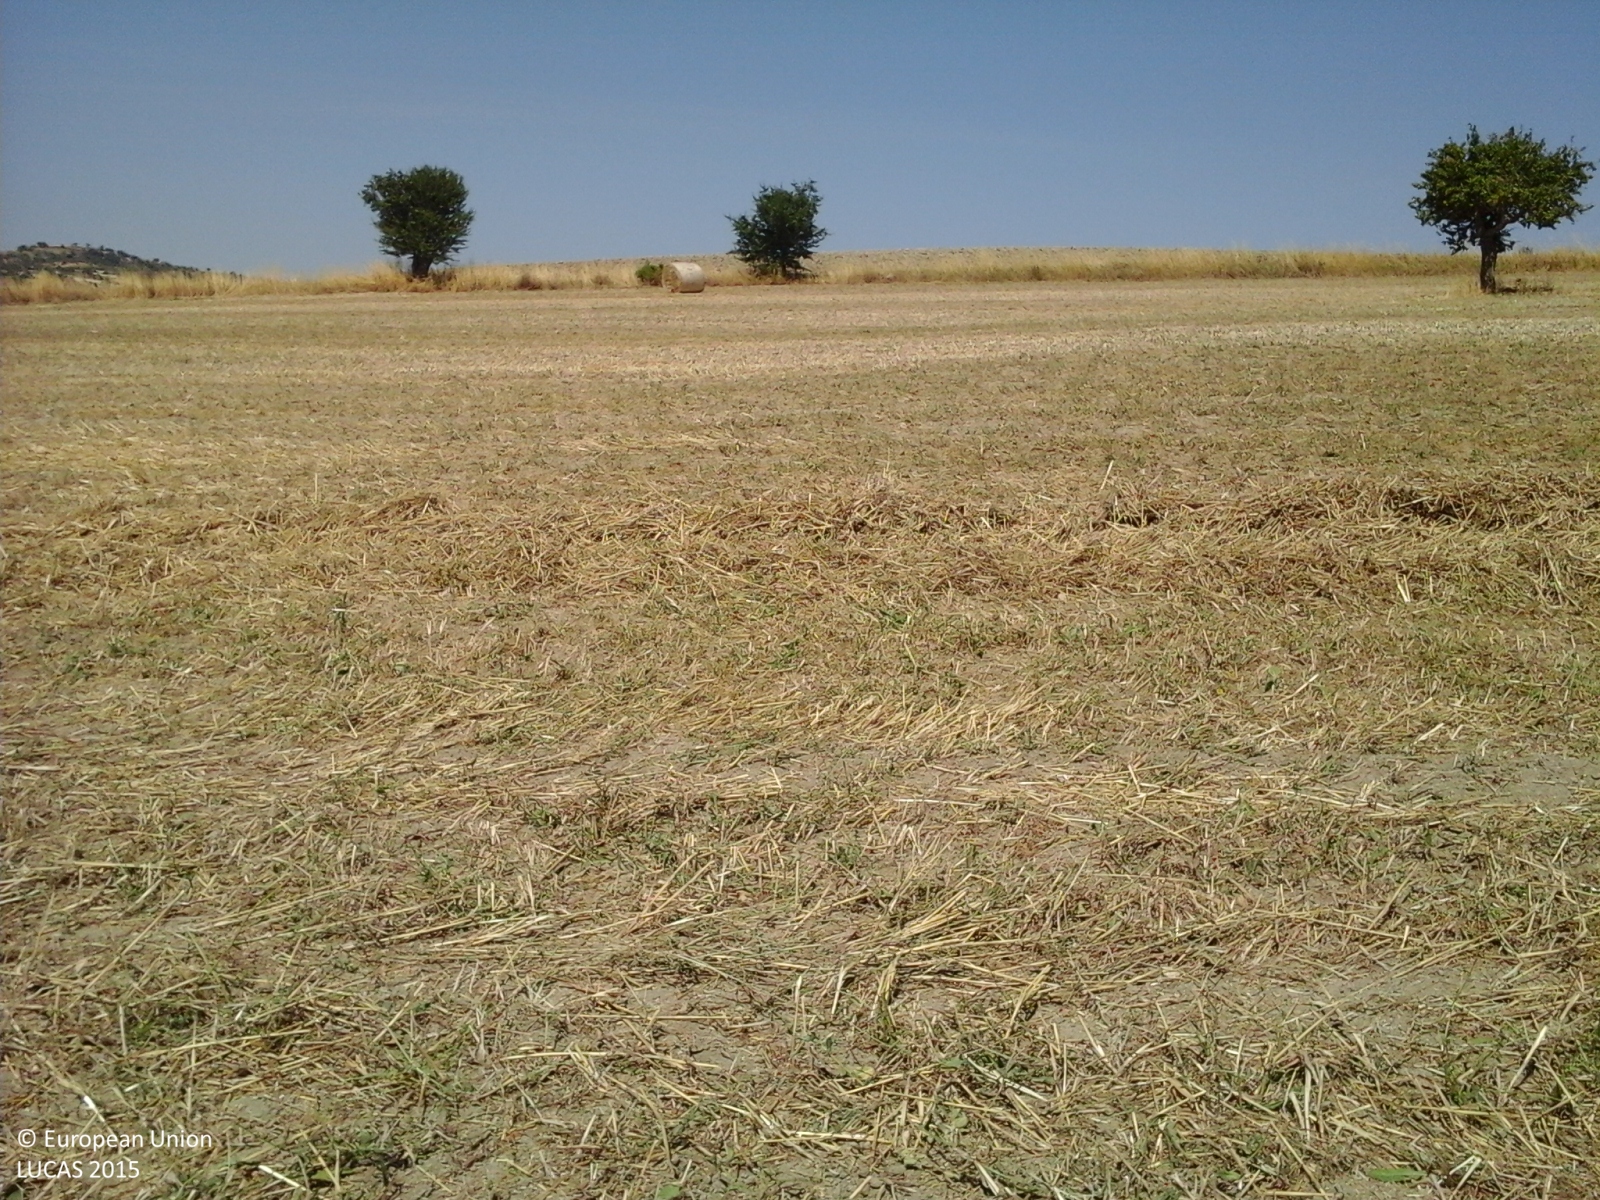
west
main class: Cropland
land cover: Durum wheat
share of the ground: > 75 %
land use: Agriculture (excluding fallow land and kitchen gardens)
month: July
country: IT
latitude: 37.0223
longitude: 14.8741
